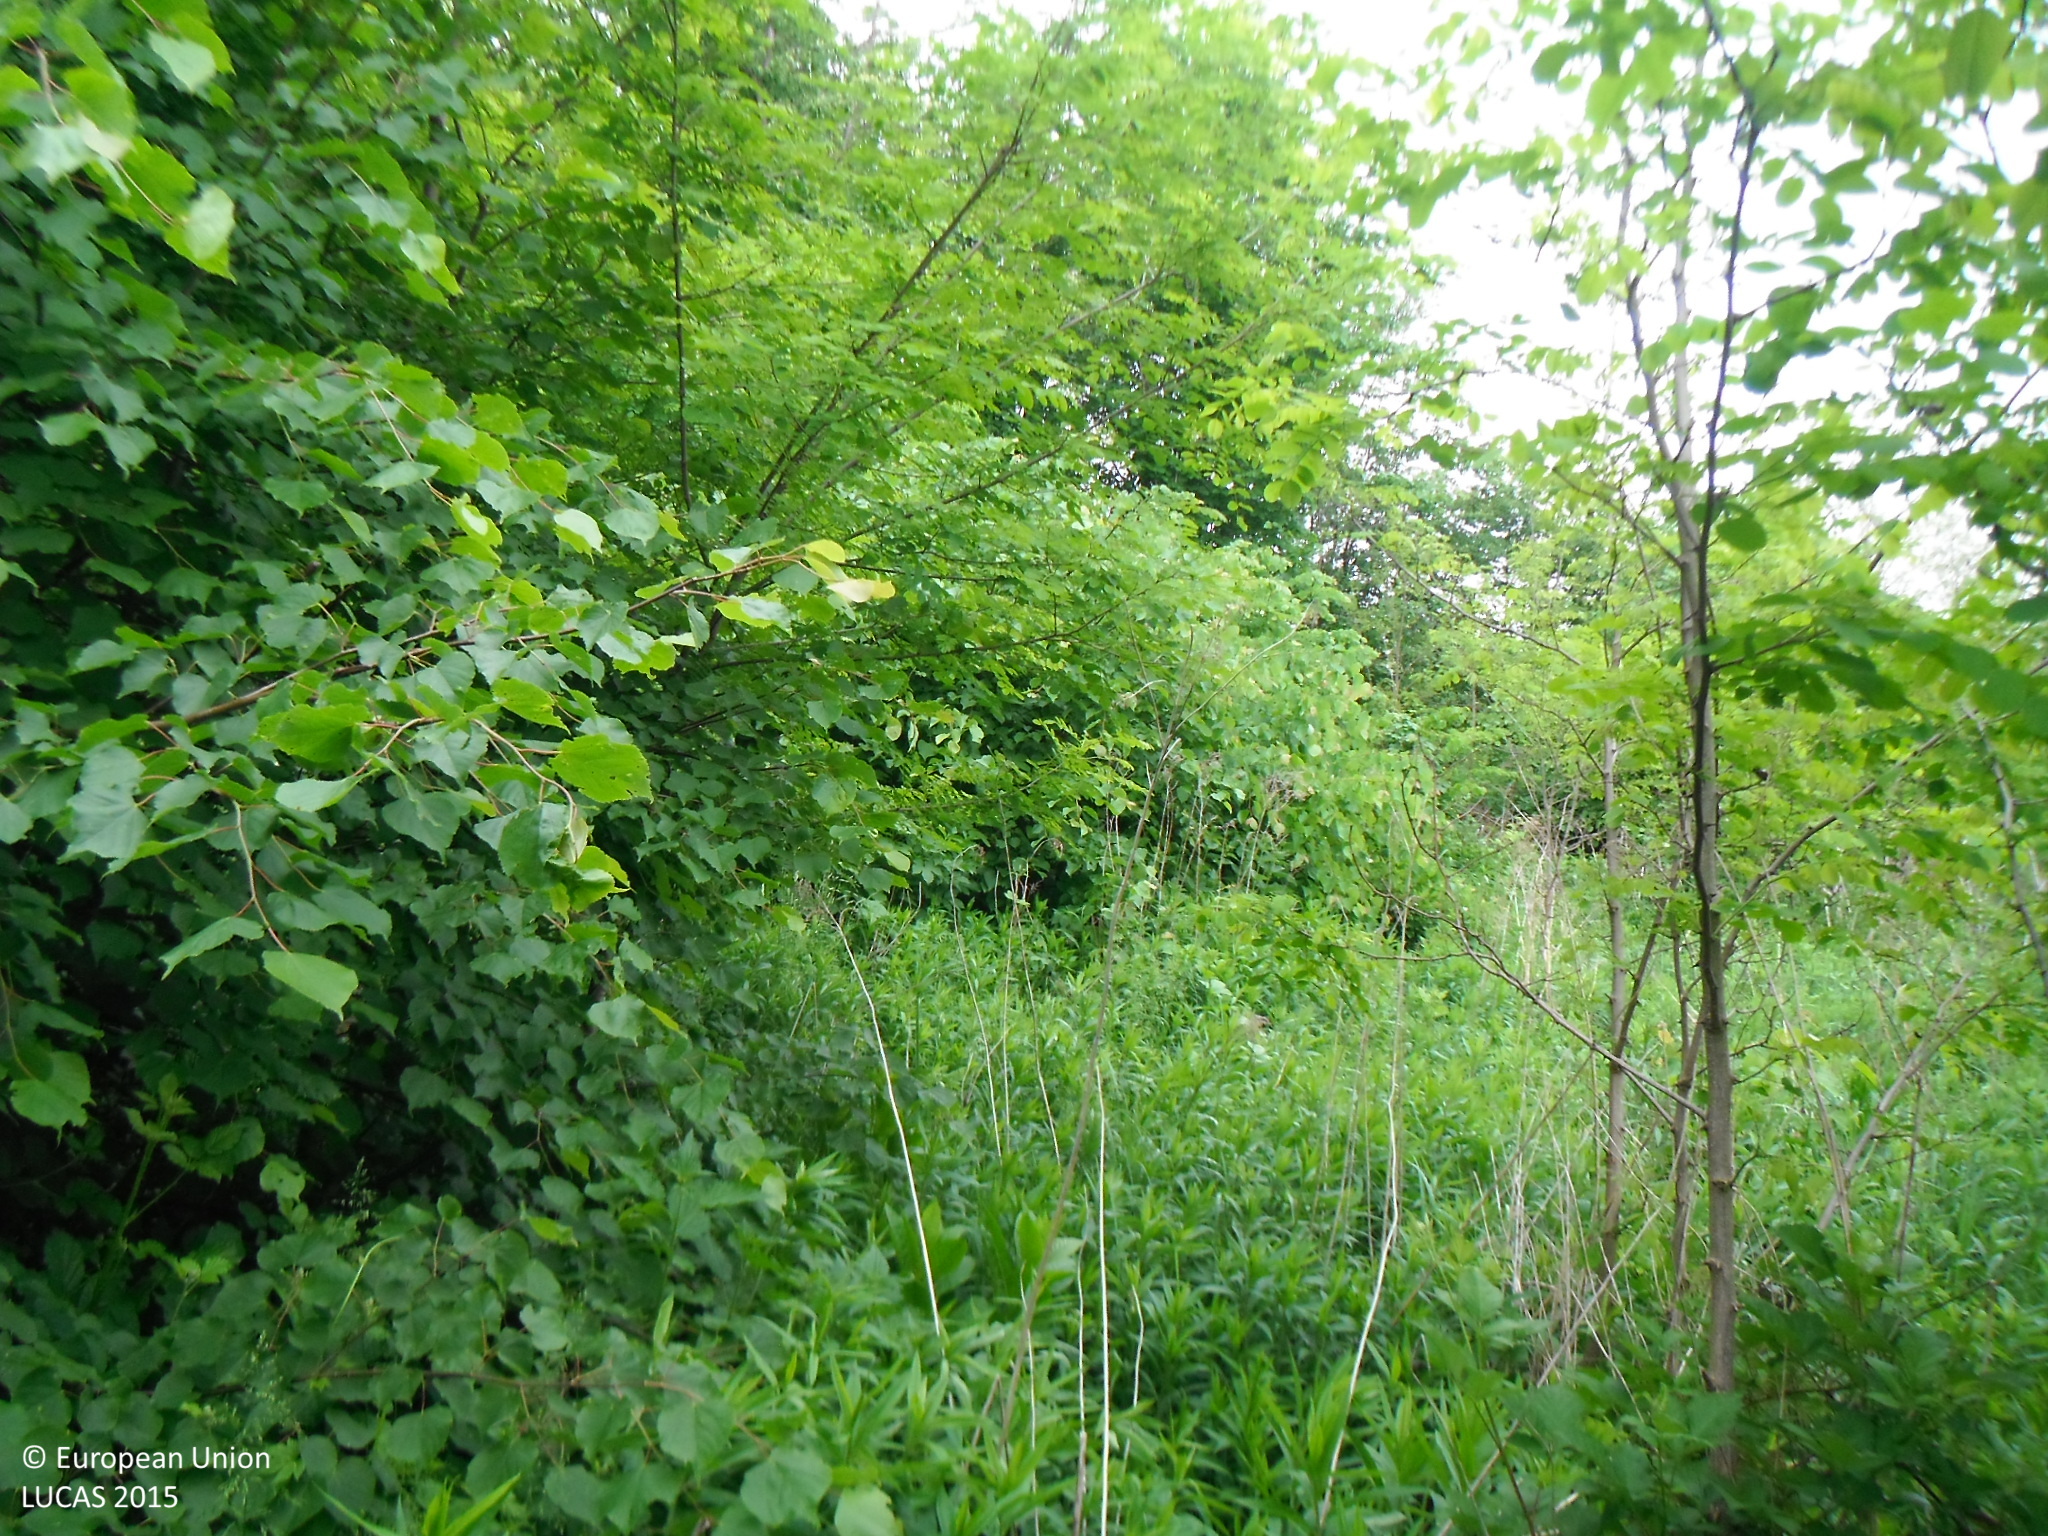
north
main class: Shrubland
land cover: Shrubland with sparse tree cover
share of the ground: > 75 %
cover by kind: herbaceous plants 80 %, shrubs 15 %, broadleaved forest trees 5 %
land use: Abandoned areas
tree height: < 5 m
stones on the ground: < 10 %
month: May
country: SK
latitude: 48.3971
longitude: 17.0178
